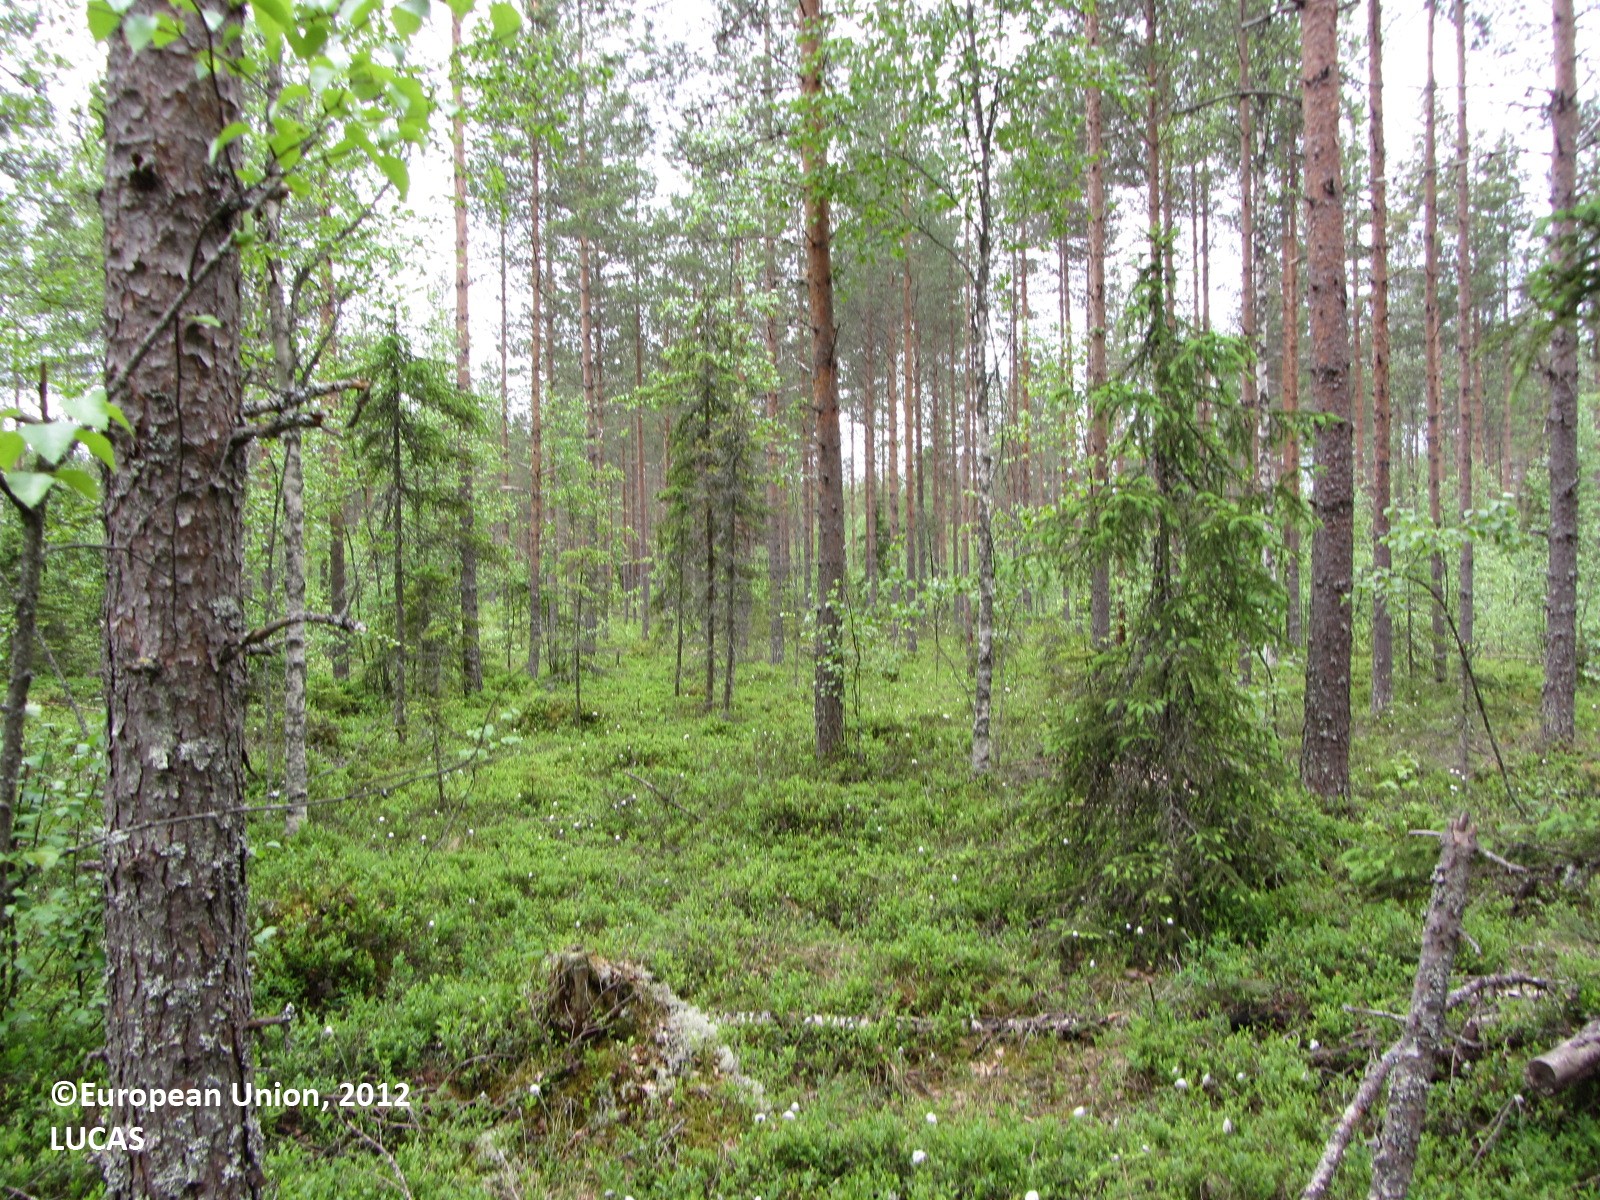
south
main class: Woodland
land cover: Other mixed woodland
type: boreal forest
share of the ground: 50 - 75 %
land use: Forestry
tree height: > 5 m
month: June
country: FI
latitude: 62.4286
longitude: 25.1520
